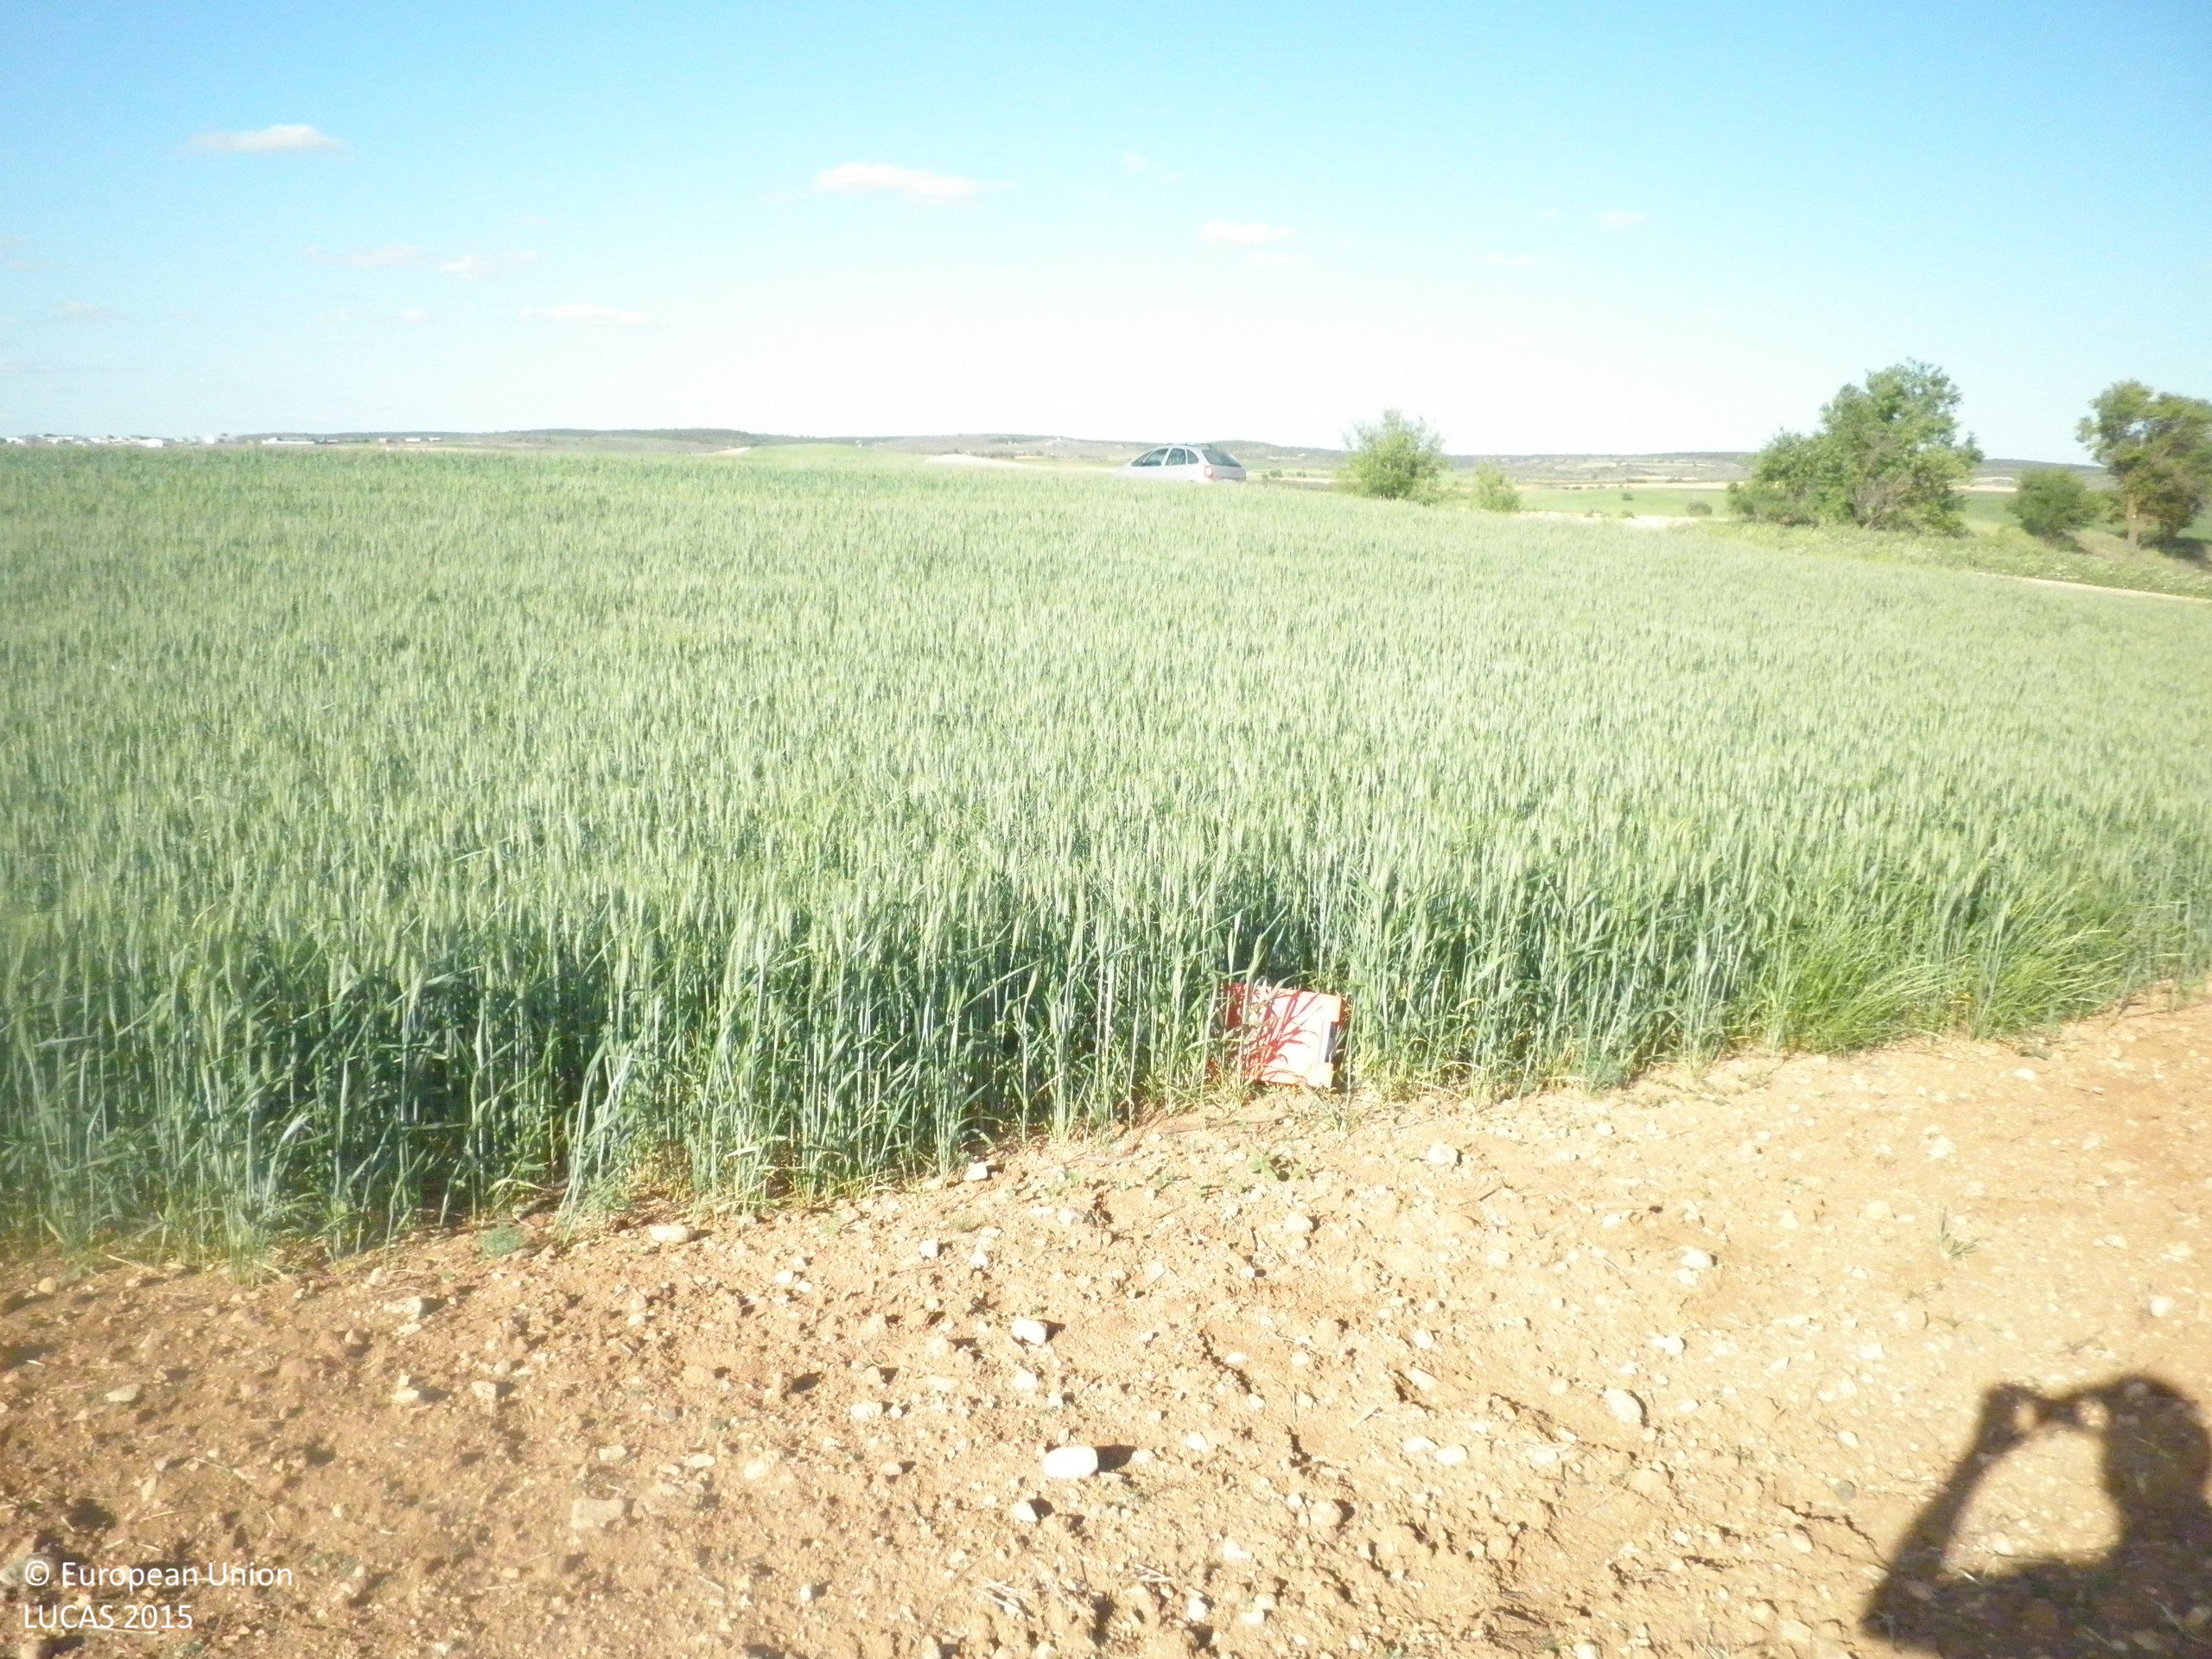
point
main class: Cropland
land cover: Rye
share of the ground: > 75 %
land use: Agriculture (excluding fallow land and kitchen gardens)
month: May
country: ES
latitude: 39.6864
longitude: -2.7616
